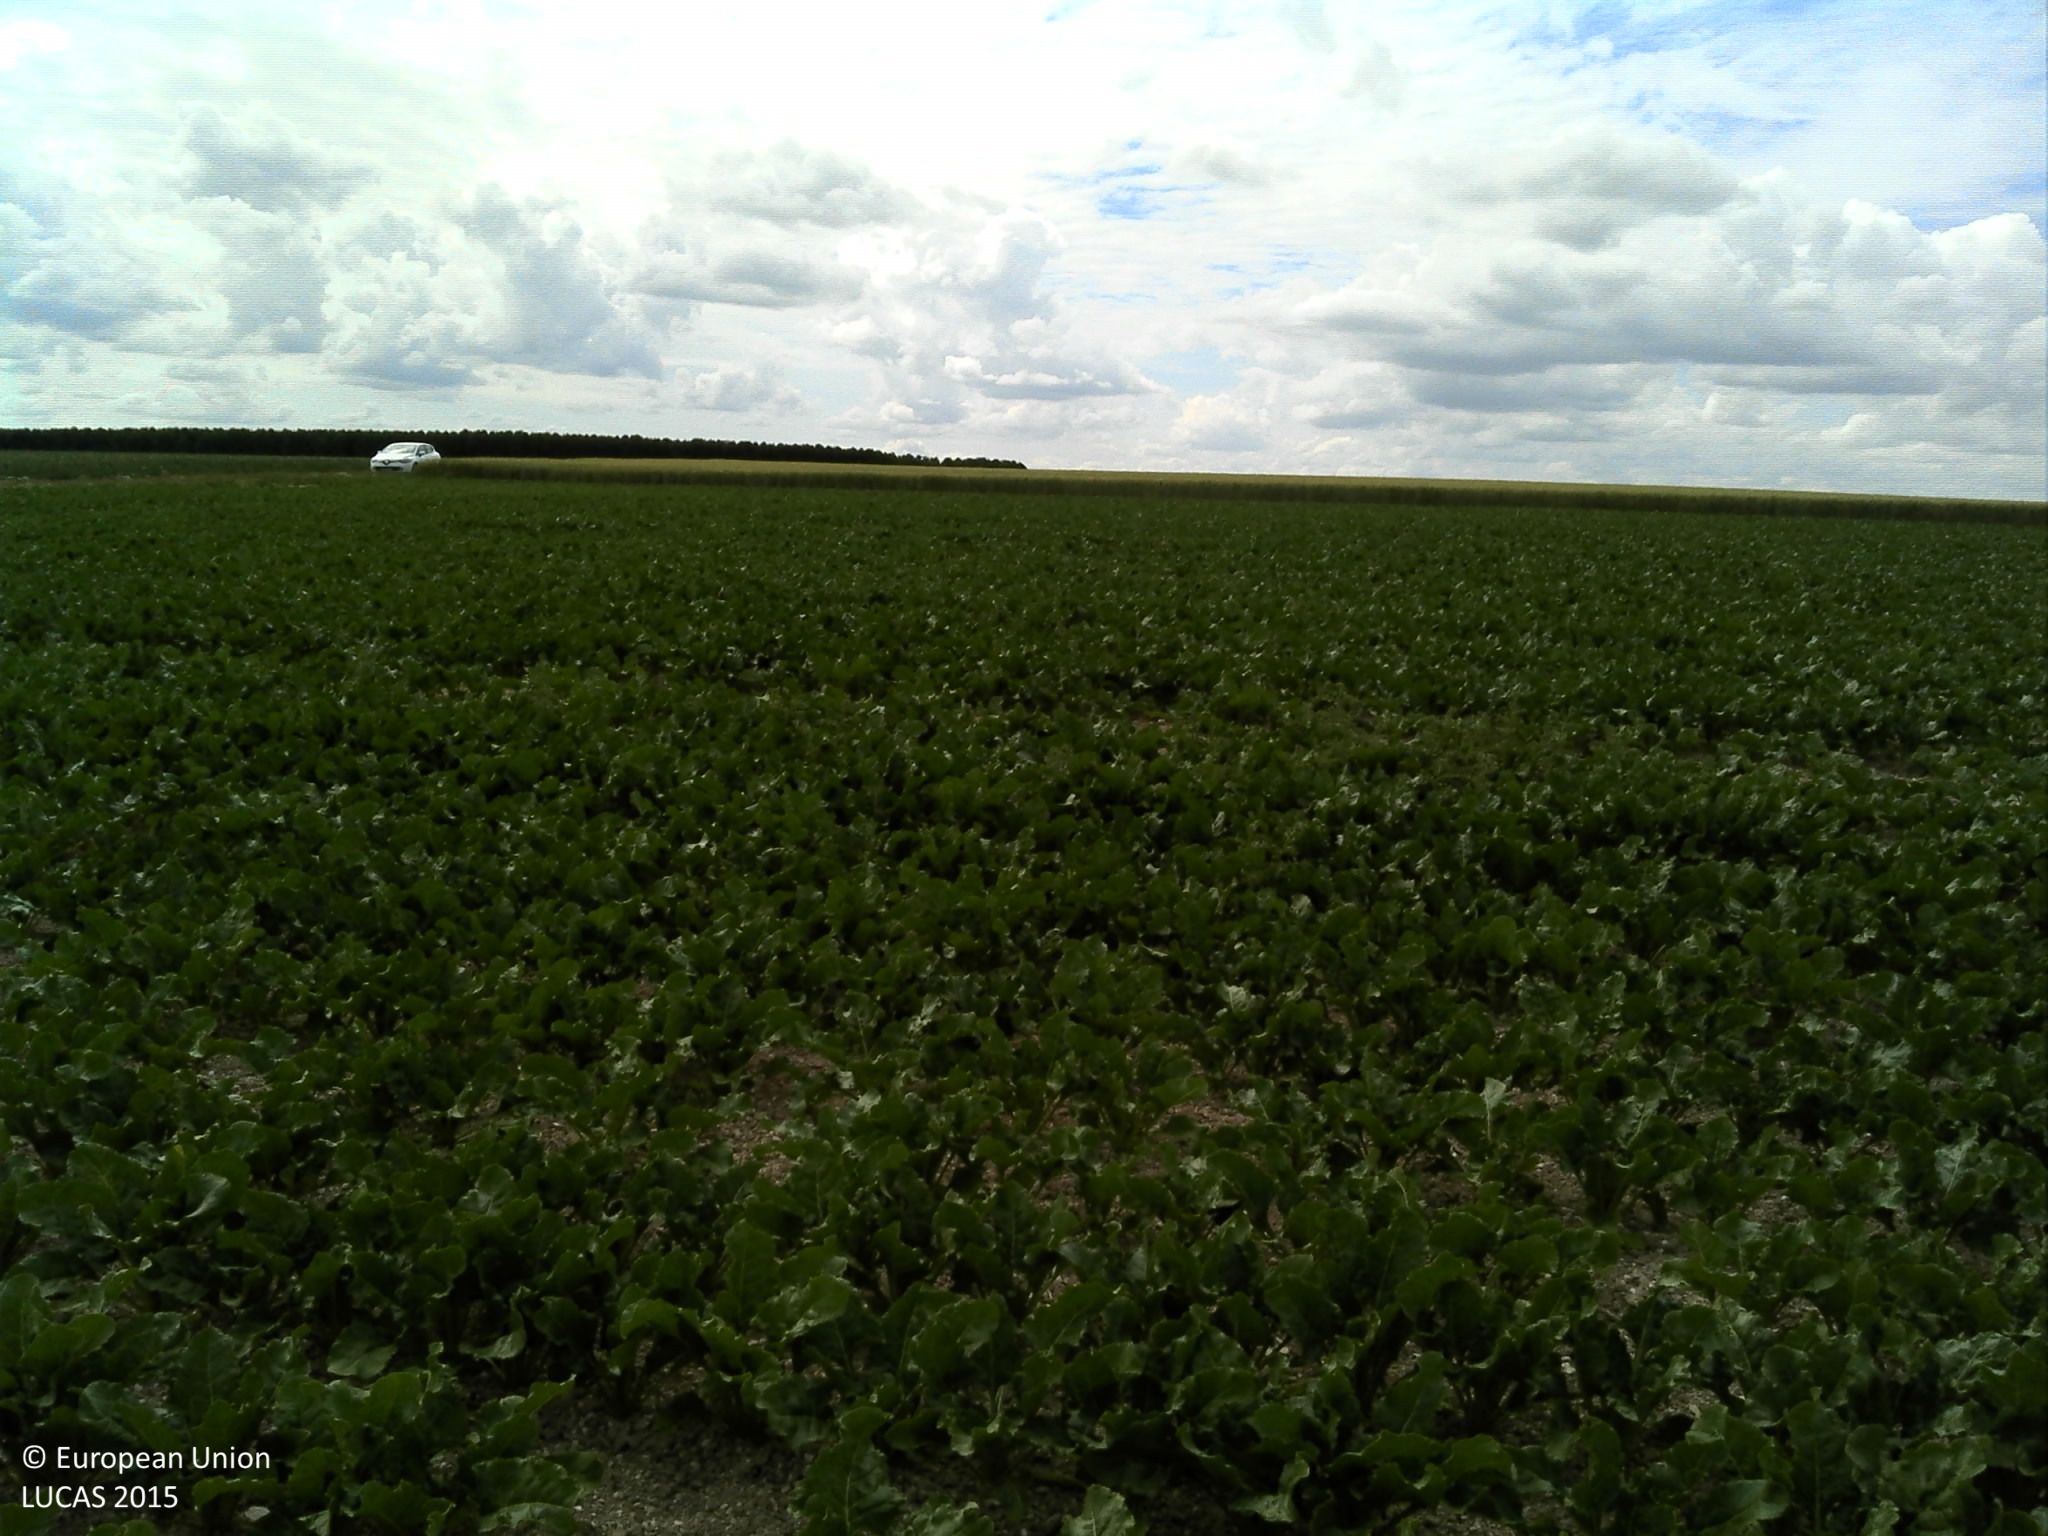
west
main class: Cropland
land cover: Sugar beet
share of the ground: 50 - 75 %
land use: Agriculture (excluding fallow land and kitchen gardens)
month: June
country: FR
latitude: 48.6826
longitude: 4.1691
